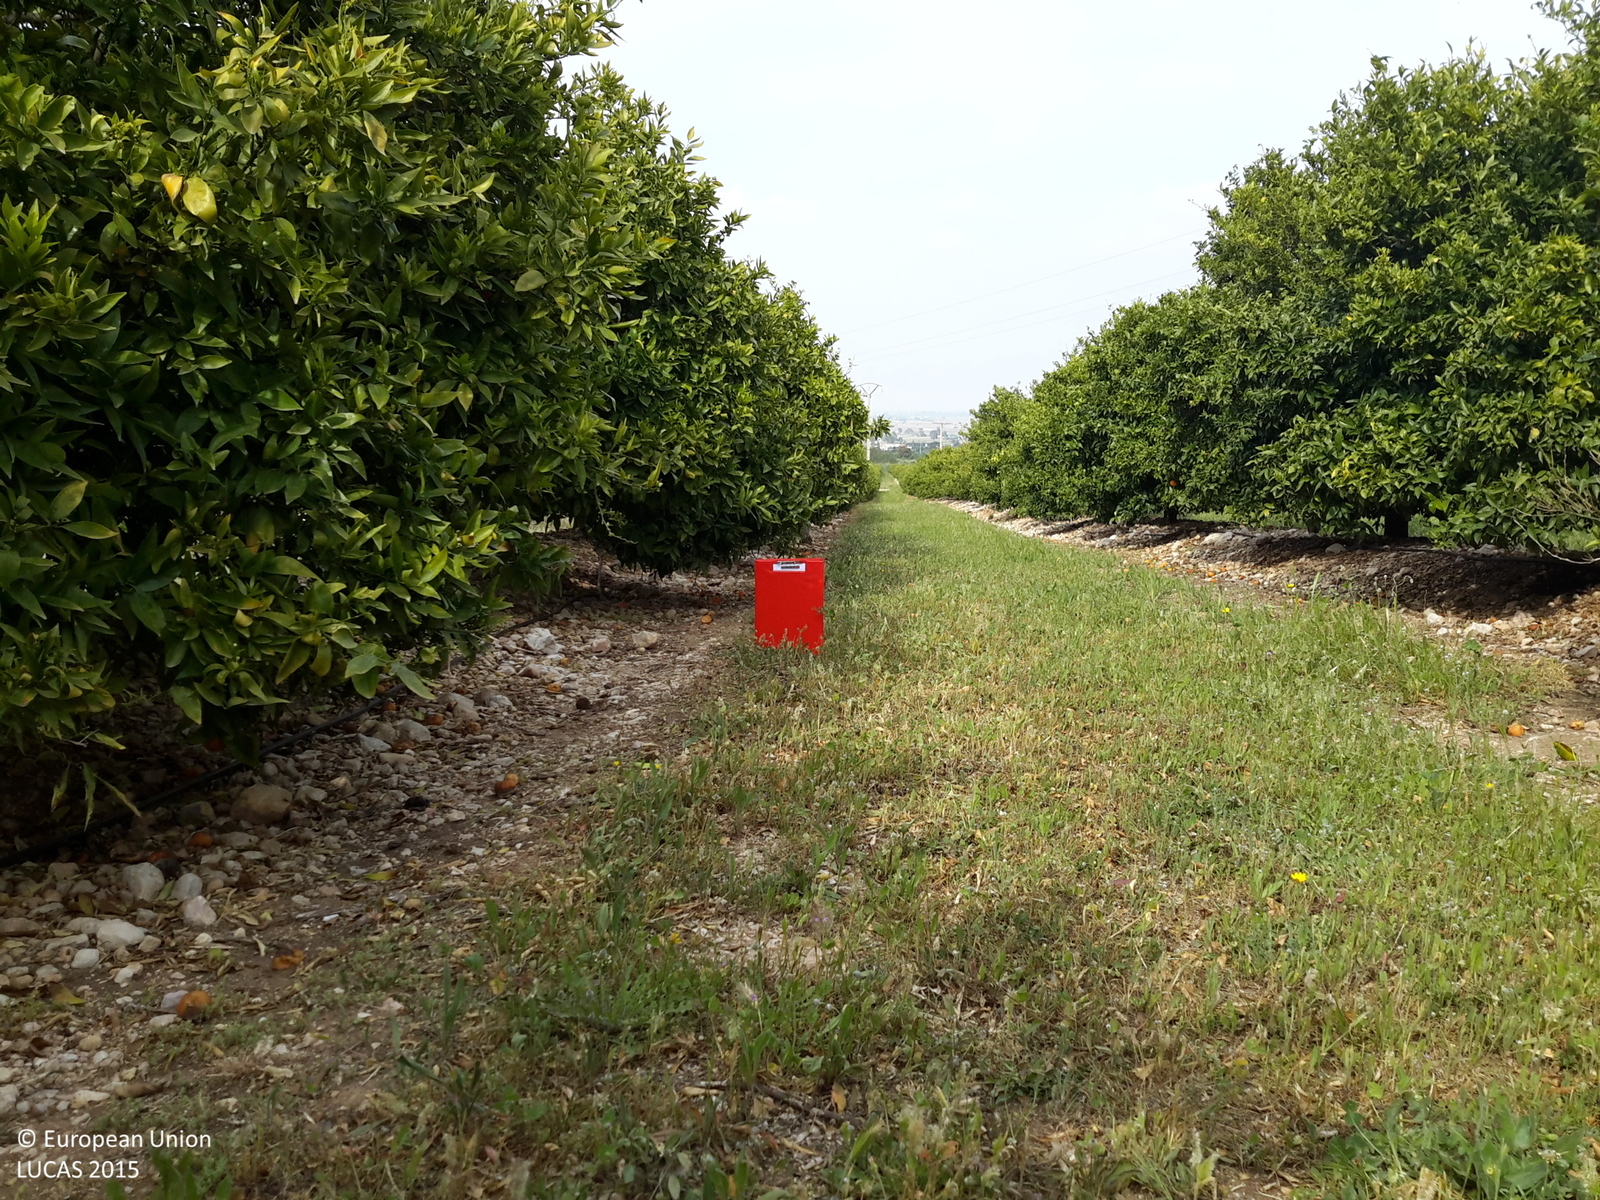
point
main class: Cropland
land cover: Oranges
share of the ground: 25 - 50 %
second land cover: Spontaneously vegetated surfaces
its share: 50 - 75 %
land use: Agriculture (excluding fallow land and kitchen gardens)
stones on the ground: > 50 %
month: April
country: ES
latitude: 40.6674
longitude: 0.5674
